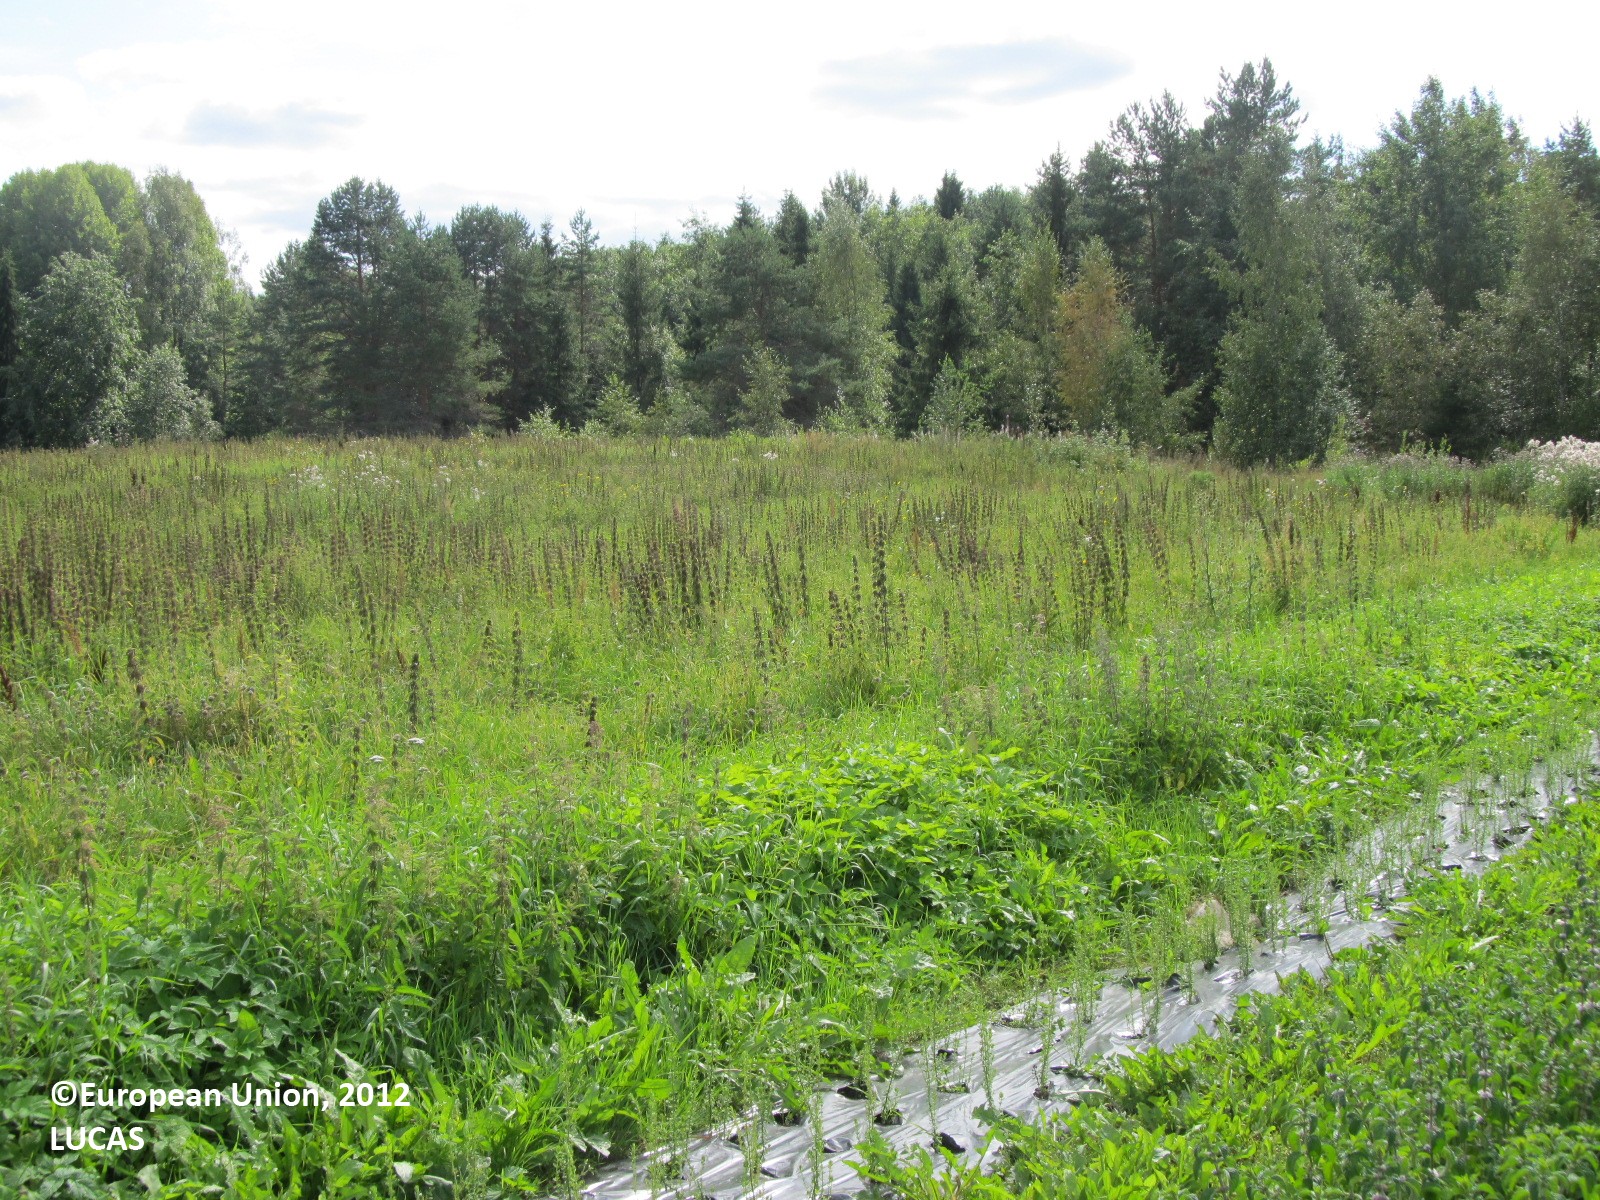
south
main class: Cropland
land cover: Other non-permanent industrial crops
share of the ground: 25 - 50 %
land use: Agriculture (excluding fallow land and kitchen gardens)
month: August
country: FI
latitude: 61.7631
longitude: 27.4726
